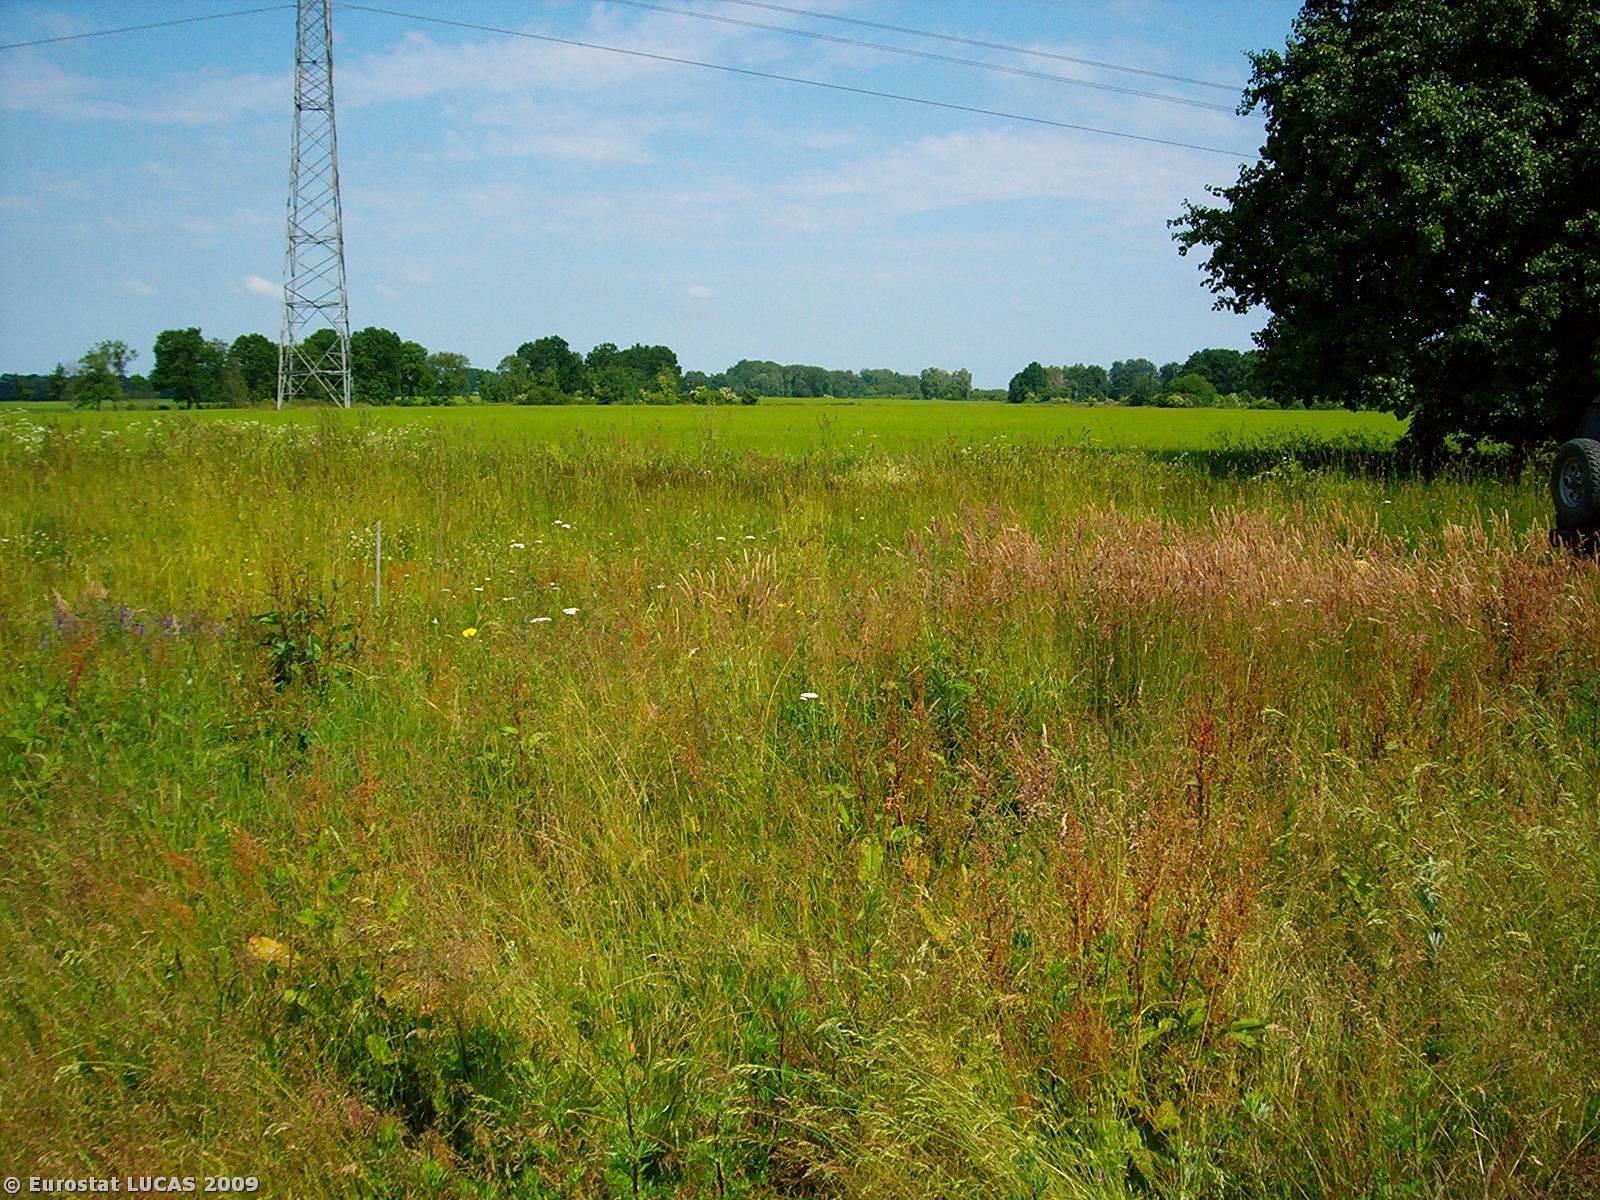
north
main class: Grassland
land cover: Grassland without tree/shrub cover
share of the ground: < 10 %
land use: Agriculture (excluding fallow land and kitchen gardens)
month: June
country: PL
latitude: 53.7079
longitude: 15.5329
